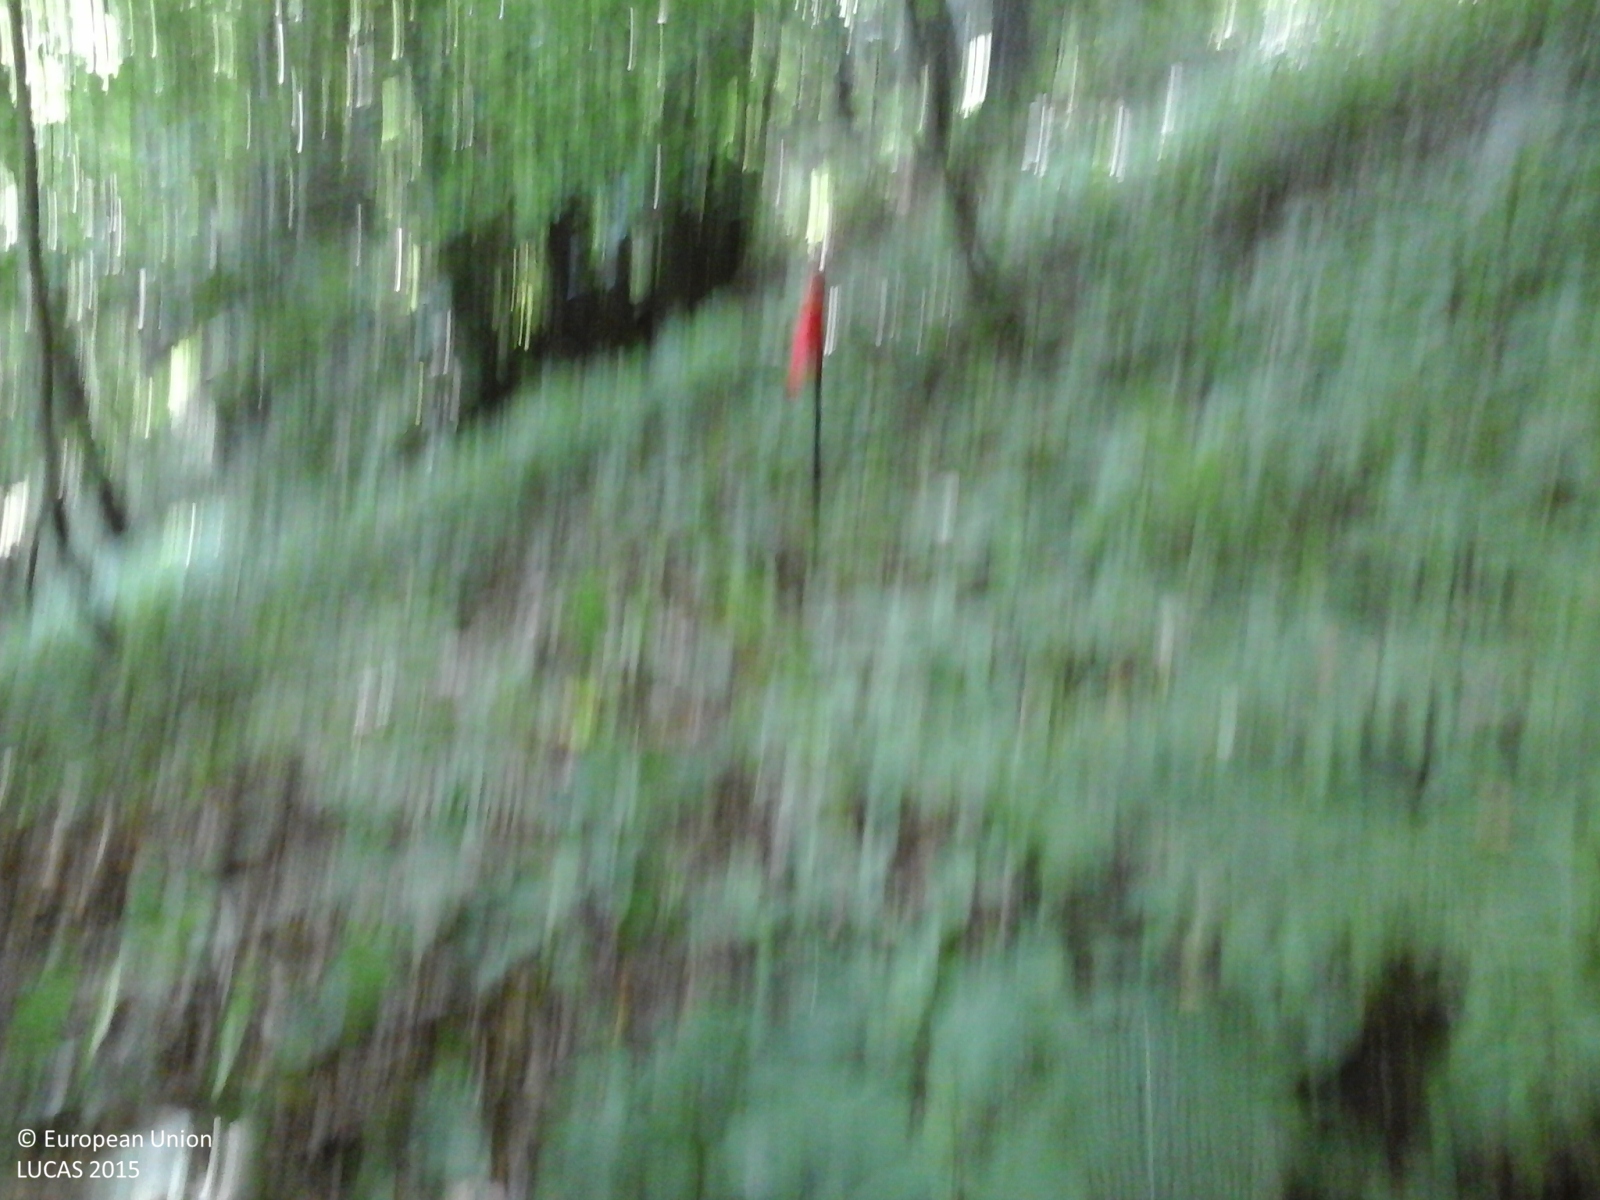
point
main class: Woodland
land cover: Broadleaved woodland
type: thermophilous deciduous forest
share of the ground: > 75 %
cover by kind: broadleaved forest trees 90 %, shrubs 10 %
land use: Forestry
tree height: > 5 m
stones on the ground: < 10 %
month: June
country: IT
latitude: 44.5867
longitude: 7.3224
